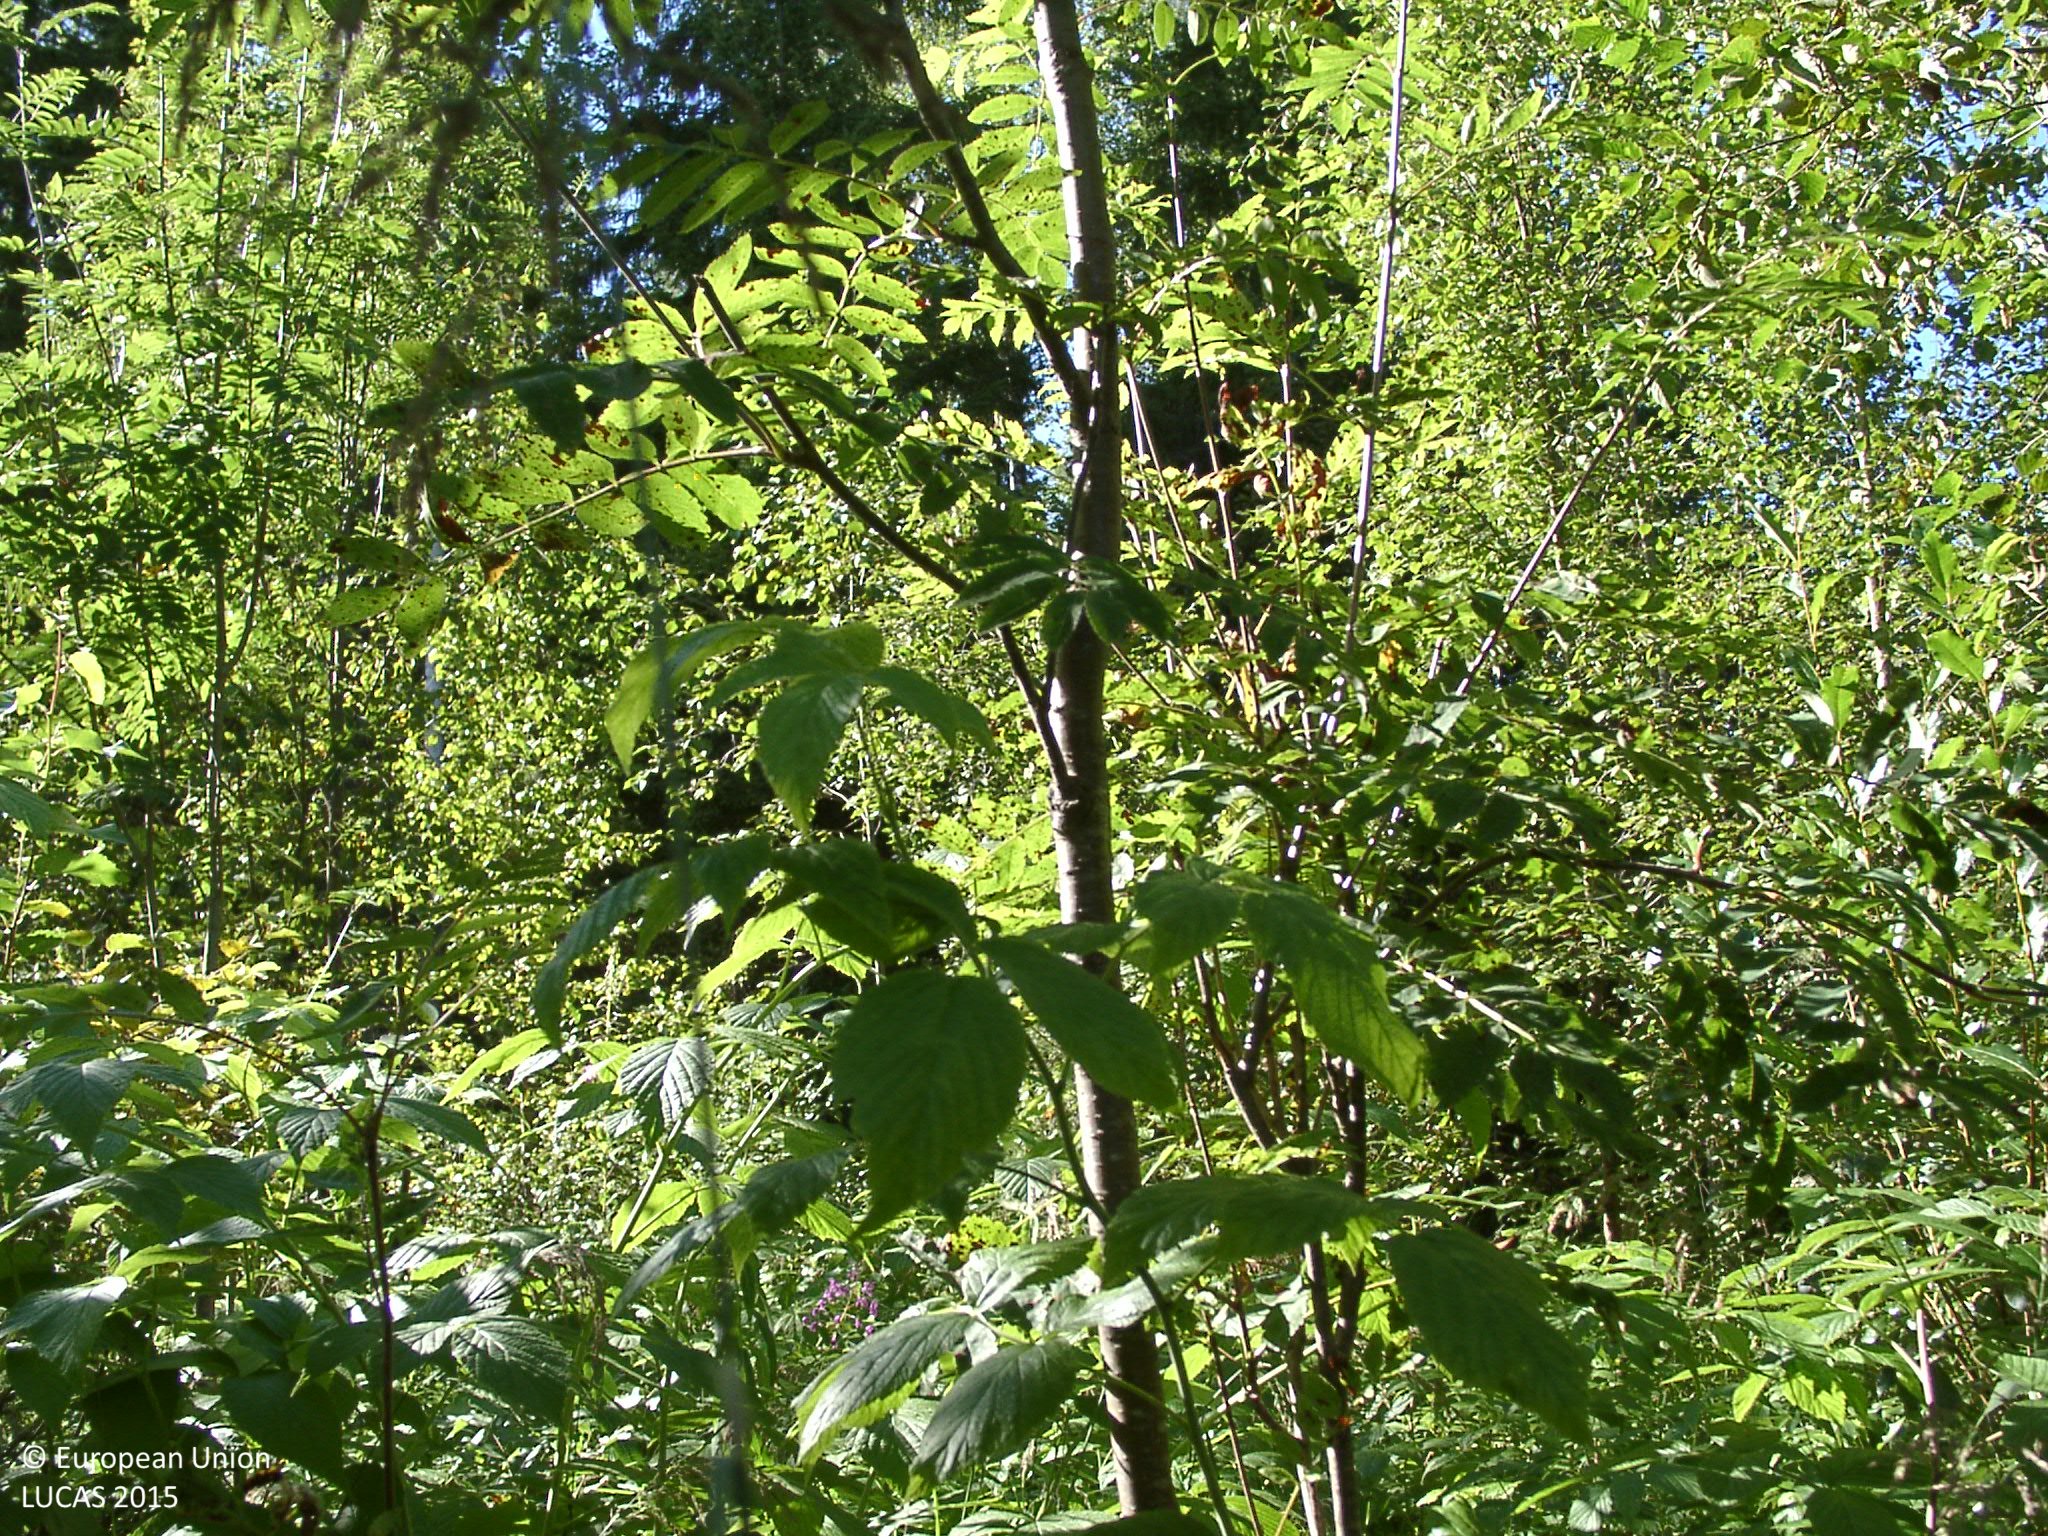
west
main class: Woodland
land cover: Broadleaved woodland
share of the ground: 50 - 75 %
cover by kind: broadleaved forest trees 60 %, shrubs 20 %, herbaceous plants 20 %
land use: Forestry
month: August
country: FI
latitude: 62.3703
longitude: 25.3601
